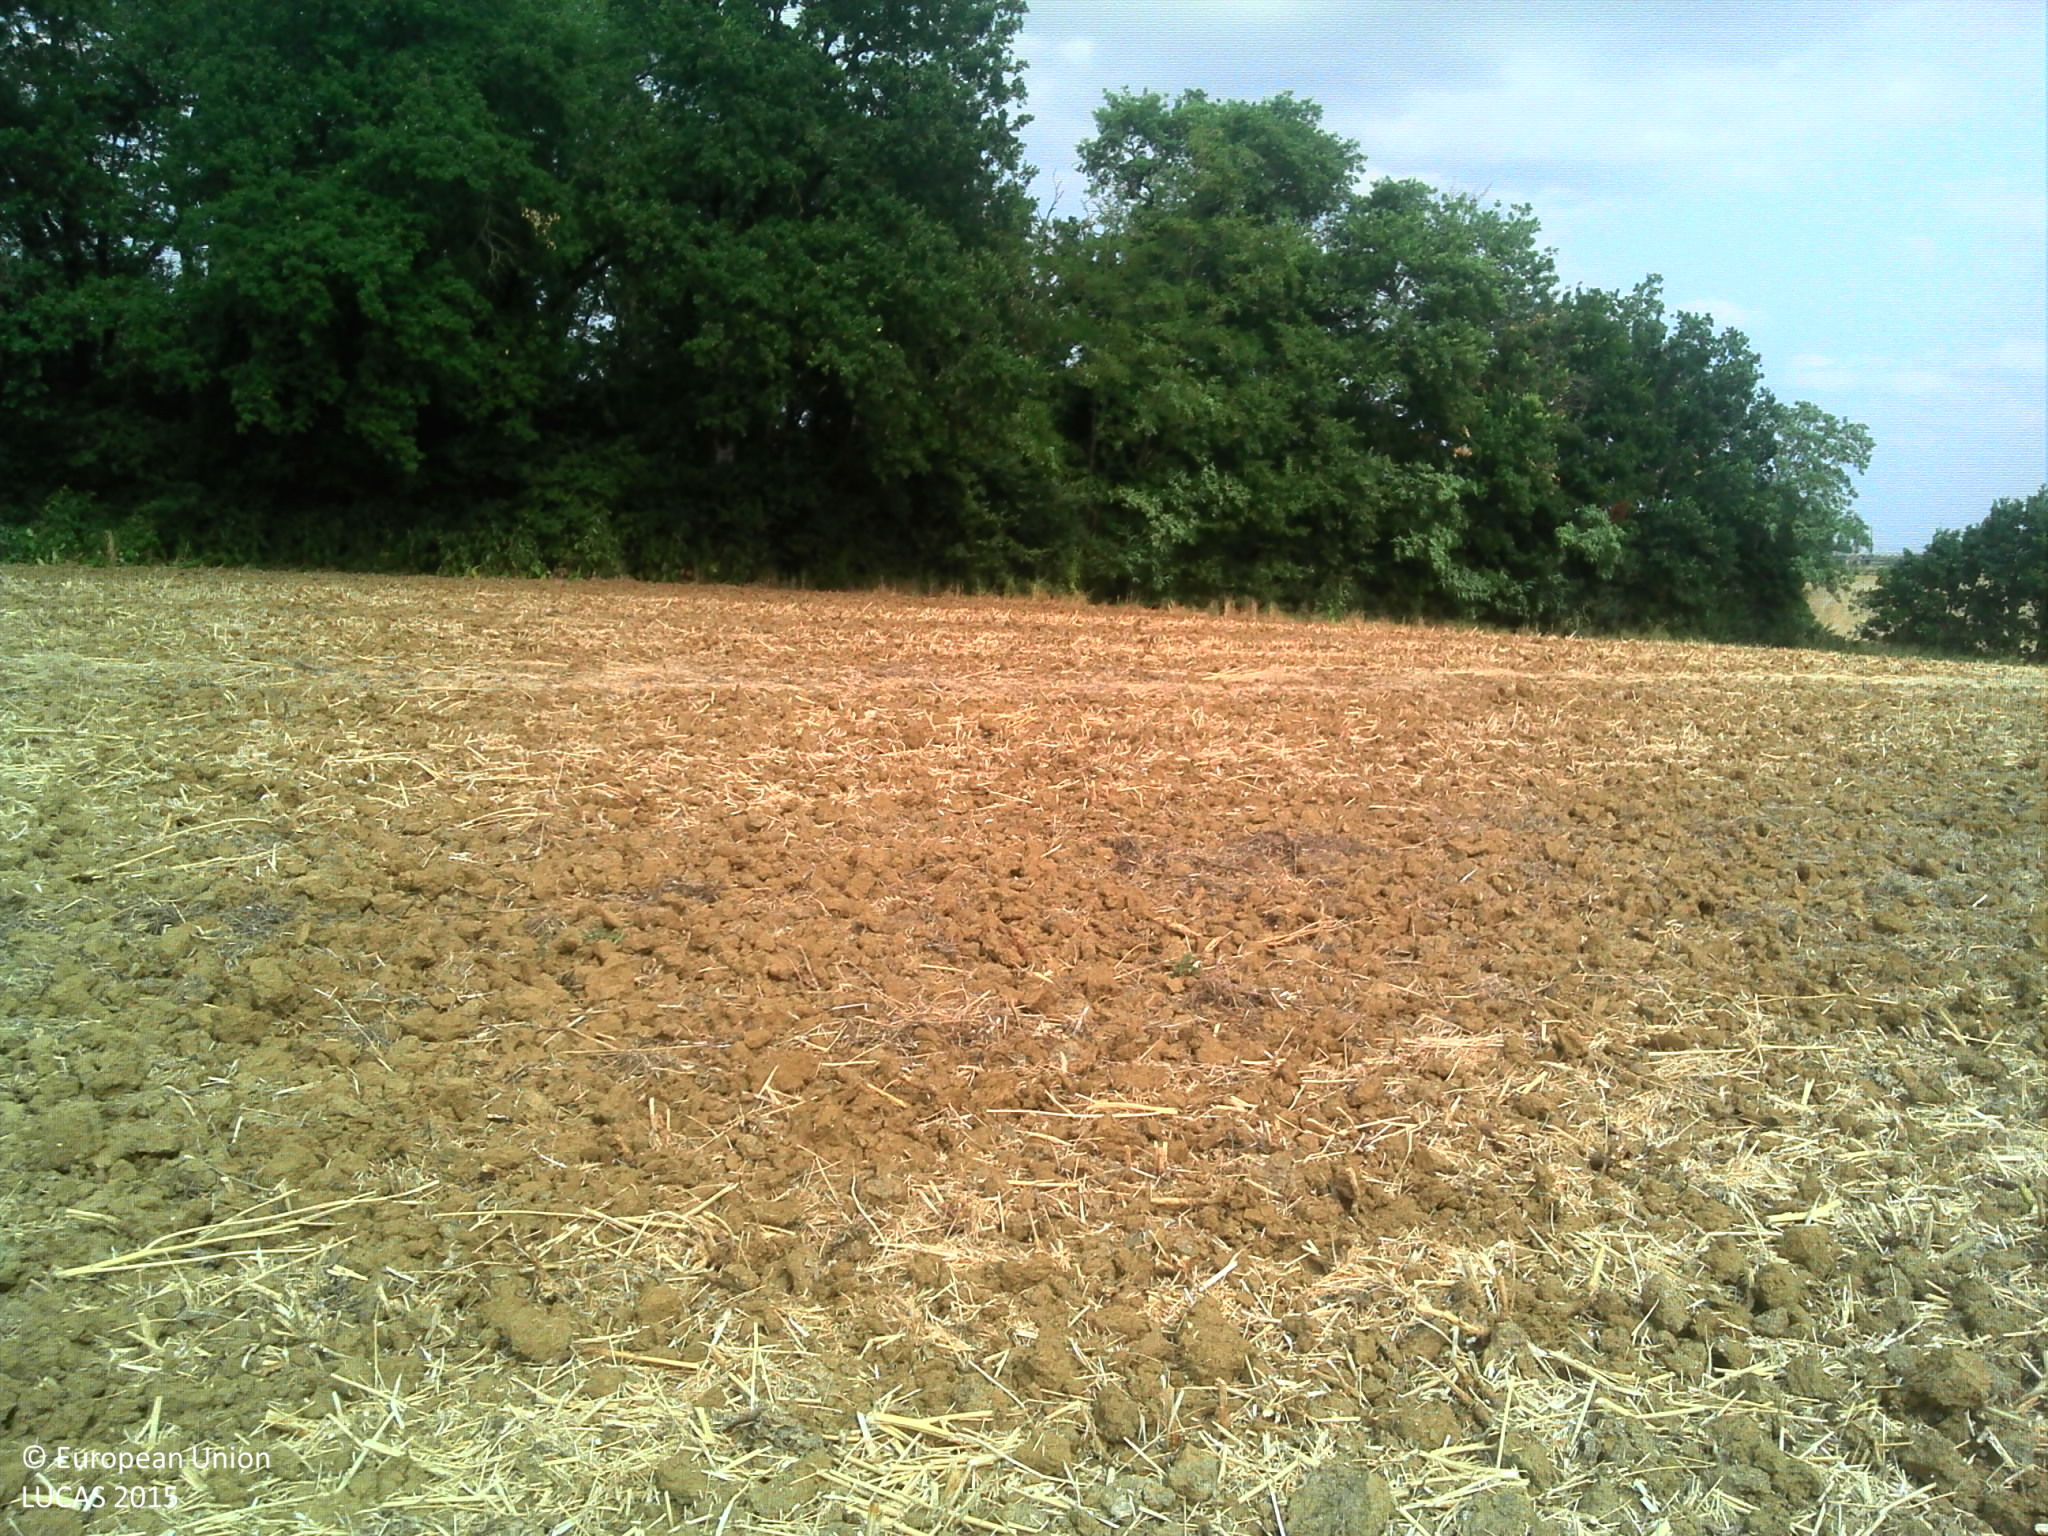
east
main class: Cropland
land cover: Rape and turnip rape
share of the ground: 10 - 25 %
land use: Agriculture (excluding fallow land and kitchen gardens)
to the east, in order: Rape and turnip rape; Broadleaved woodland; Barley
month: July
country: FR
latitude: 44.2619
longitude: 0.9400
